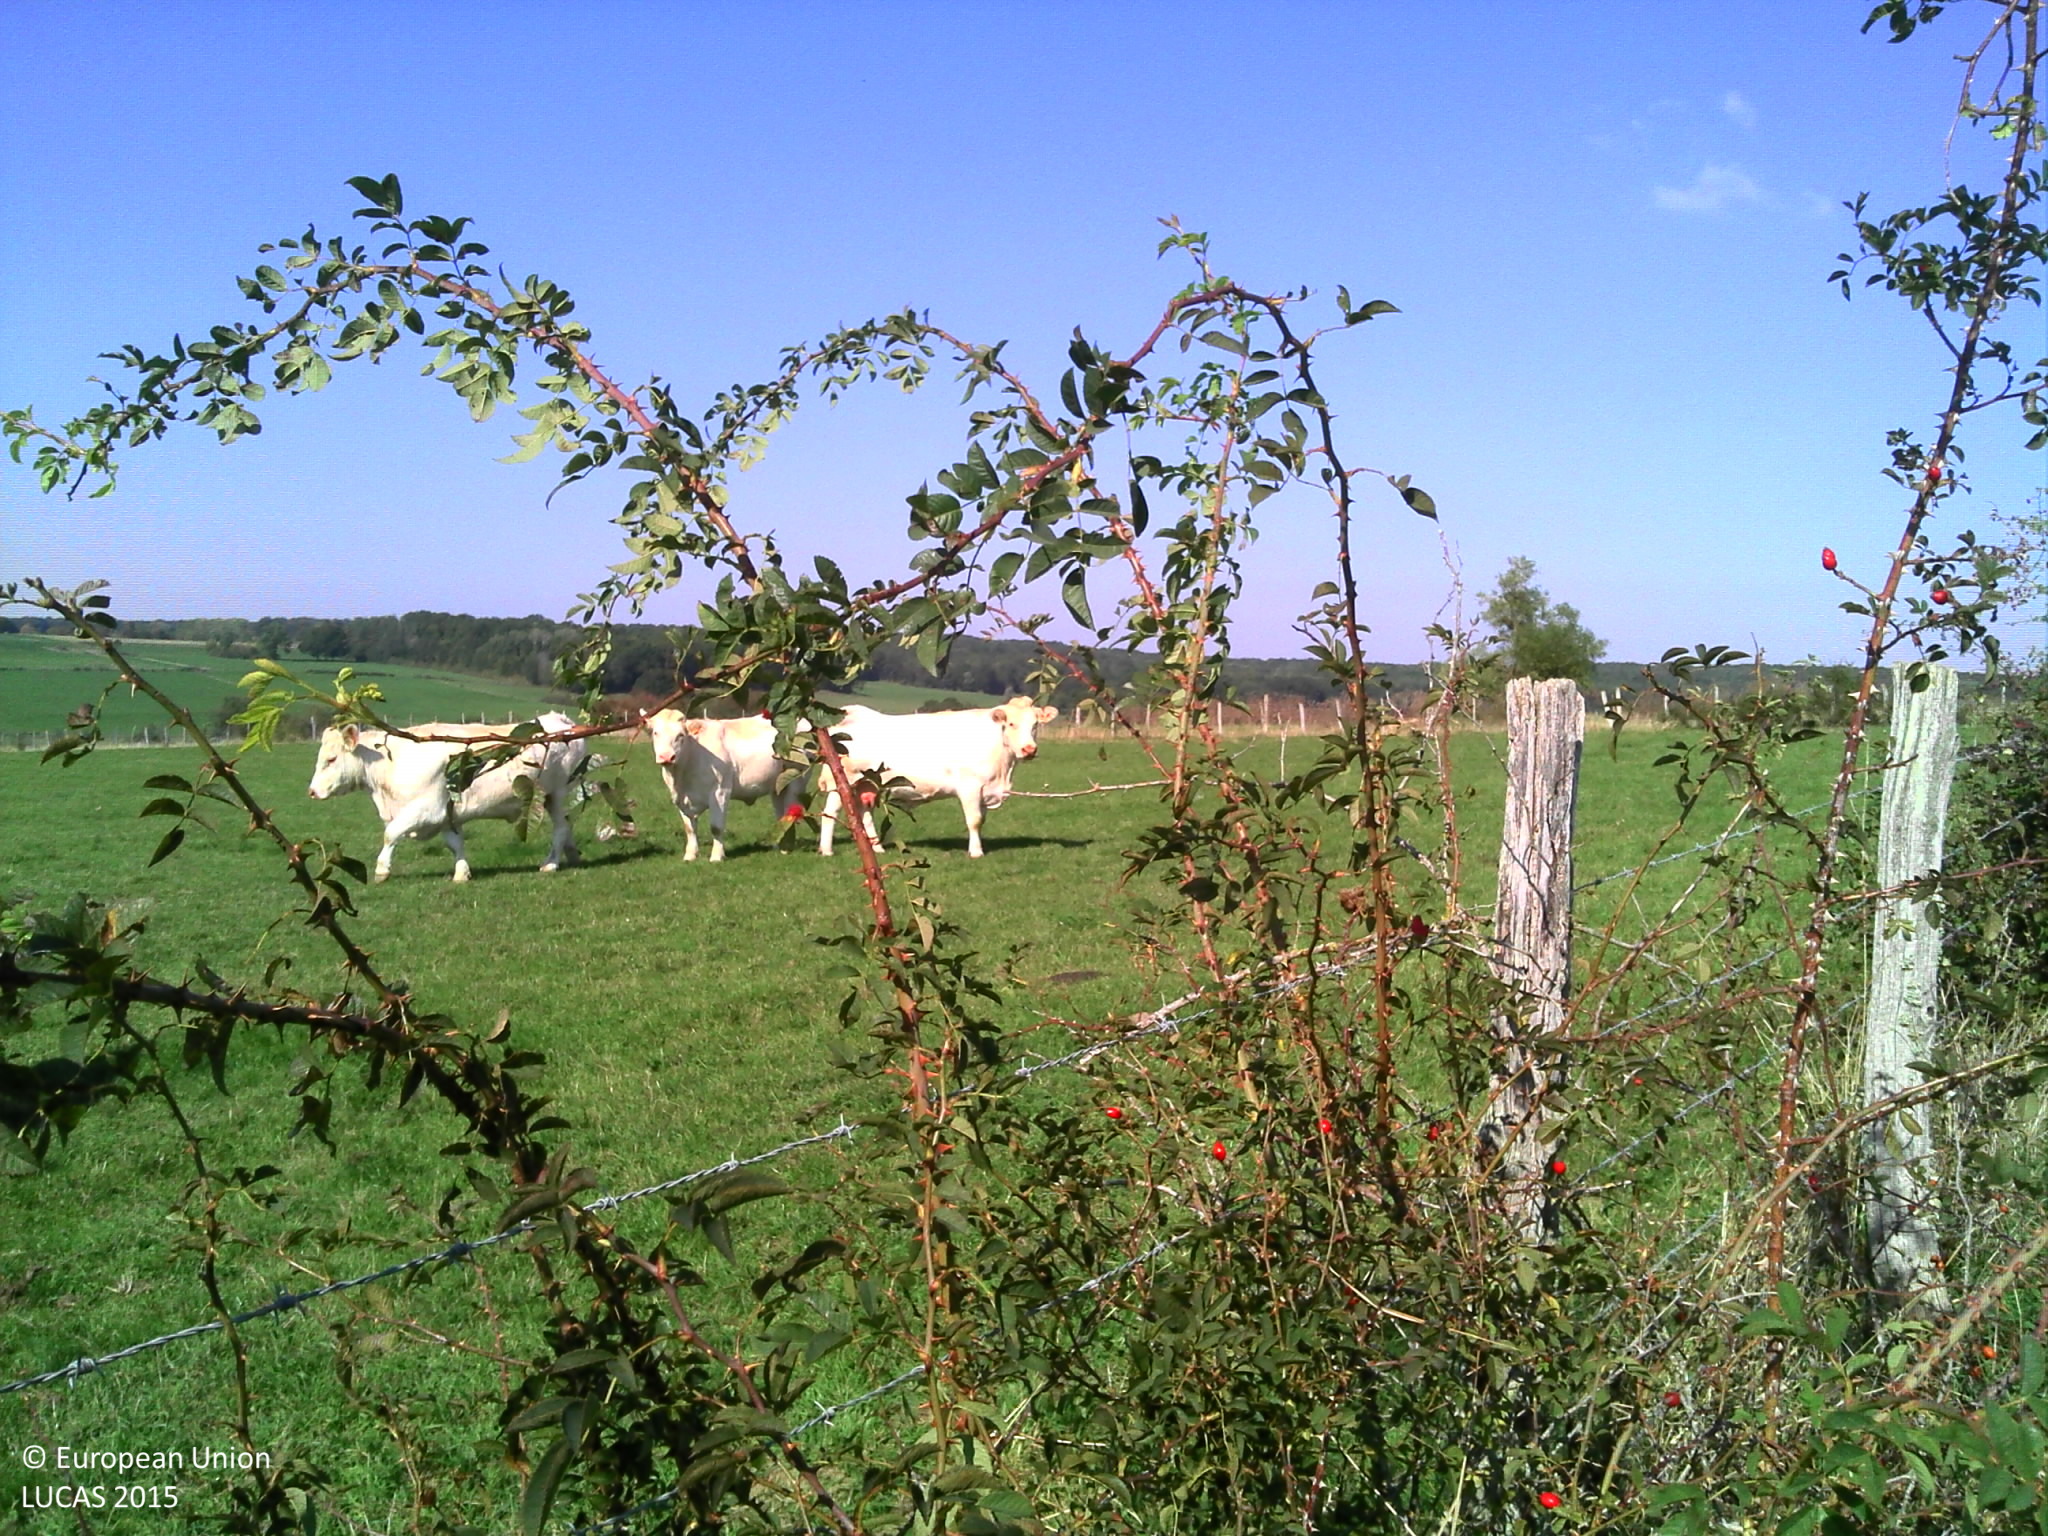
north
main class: Grassland
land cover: Grassland without tree/shrub cover
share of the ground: > 75 %
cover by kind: herbaceous plants 100 %
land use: Agriculture (excluding fallow land and kitchen gardens)
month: October
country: FR
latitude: 47.9466
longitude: 3.9046
